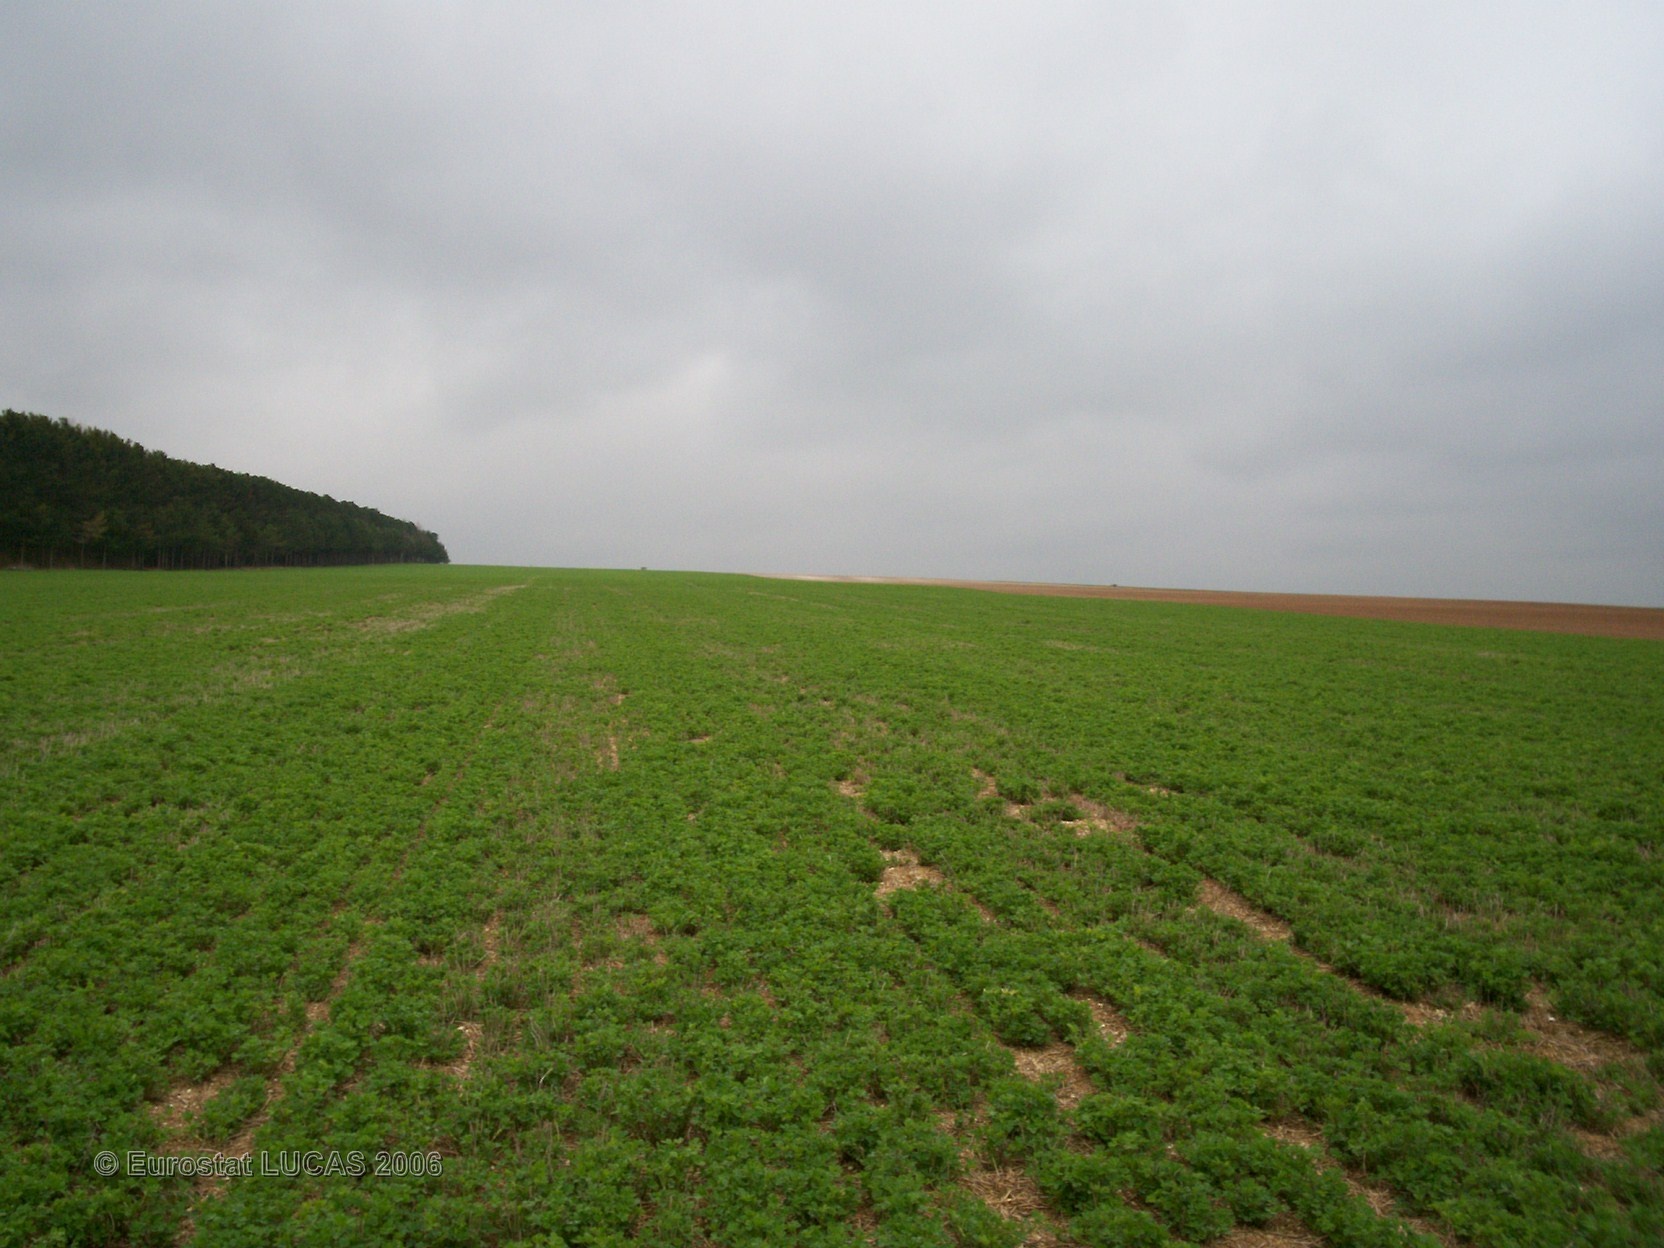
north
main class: Cropland
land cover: Lucerne
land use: Agriculture (excluding fallow land and kitchen gardens)
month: April
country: FR
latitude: 49.2630
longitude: 4.5963
